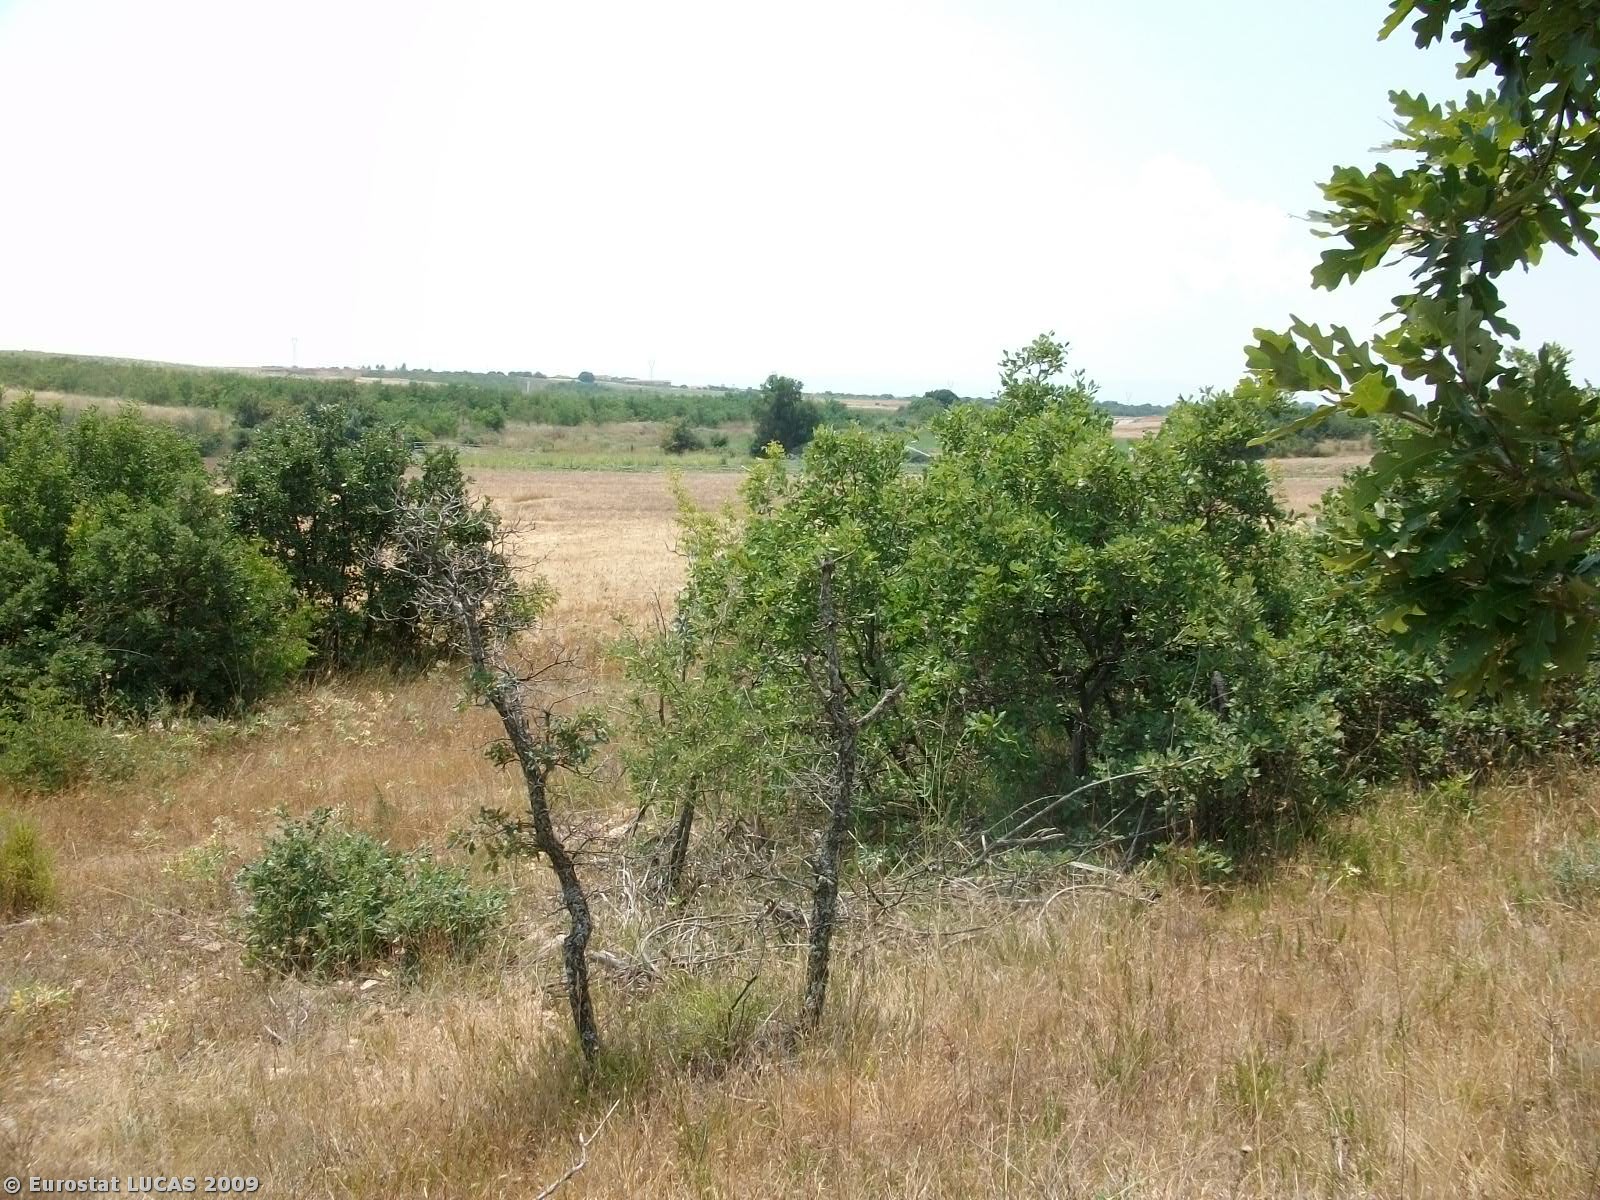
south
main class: Shrubland
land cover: Shrubland with sparse tree cover
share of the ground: 25 - 50 %
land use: Unused
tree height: < 5 m
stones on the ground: 25 - 50 %
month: July
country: GR
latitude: 40.9520
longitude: 26.2092
